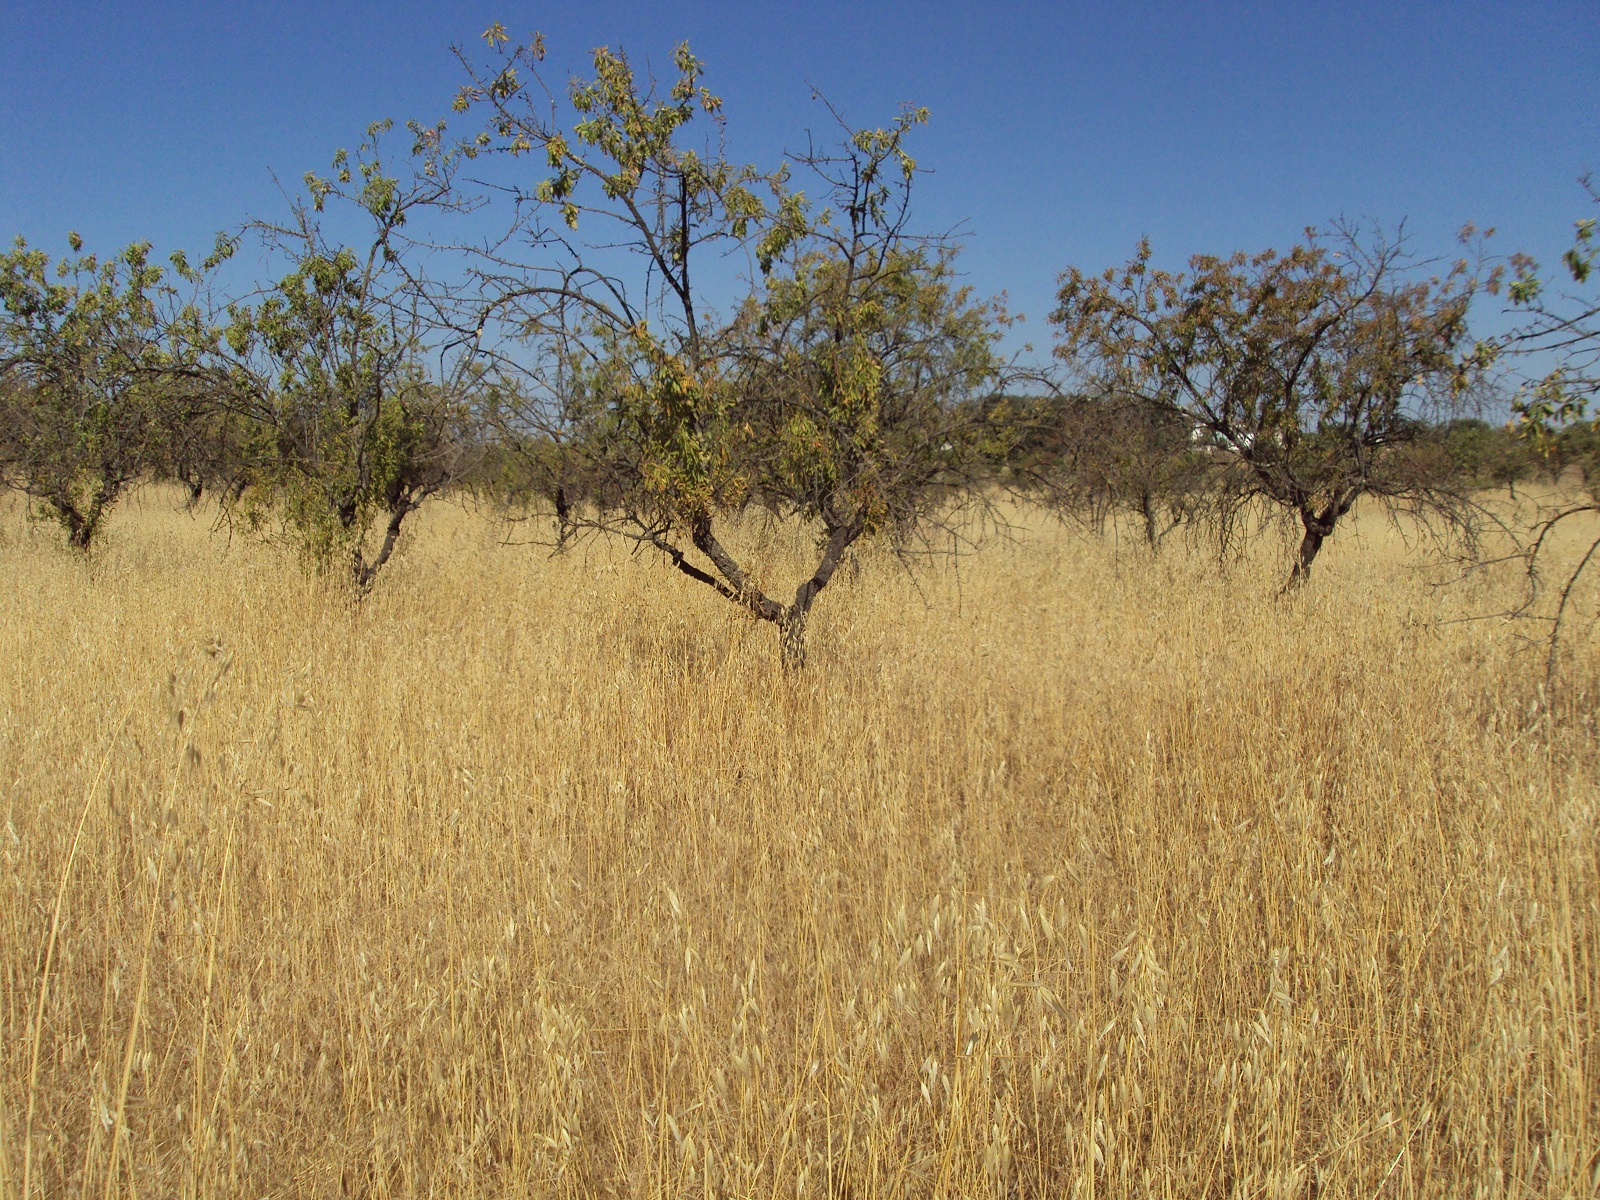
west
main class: Cropland
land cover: Nuts trees
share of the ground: 25 - 50 %
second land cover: Spontaneously vegetated surfaces
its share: > 75 %
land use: Agriculture (excluding fallow land and kitchen gardens)
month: June
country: ES
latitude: 37.4000
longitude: -6.9290
